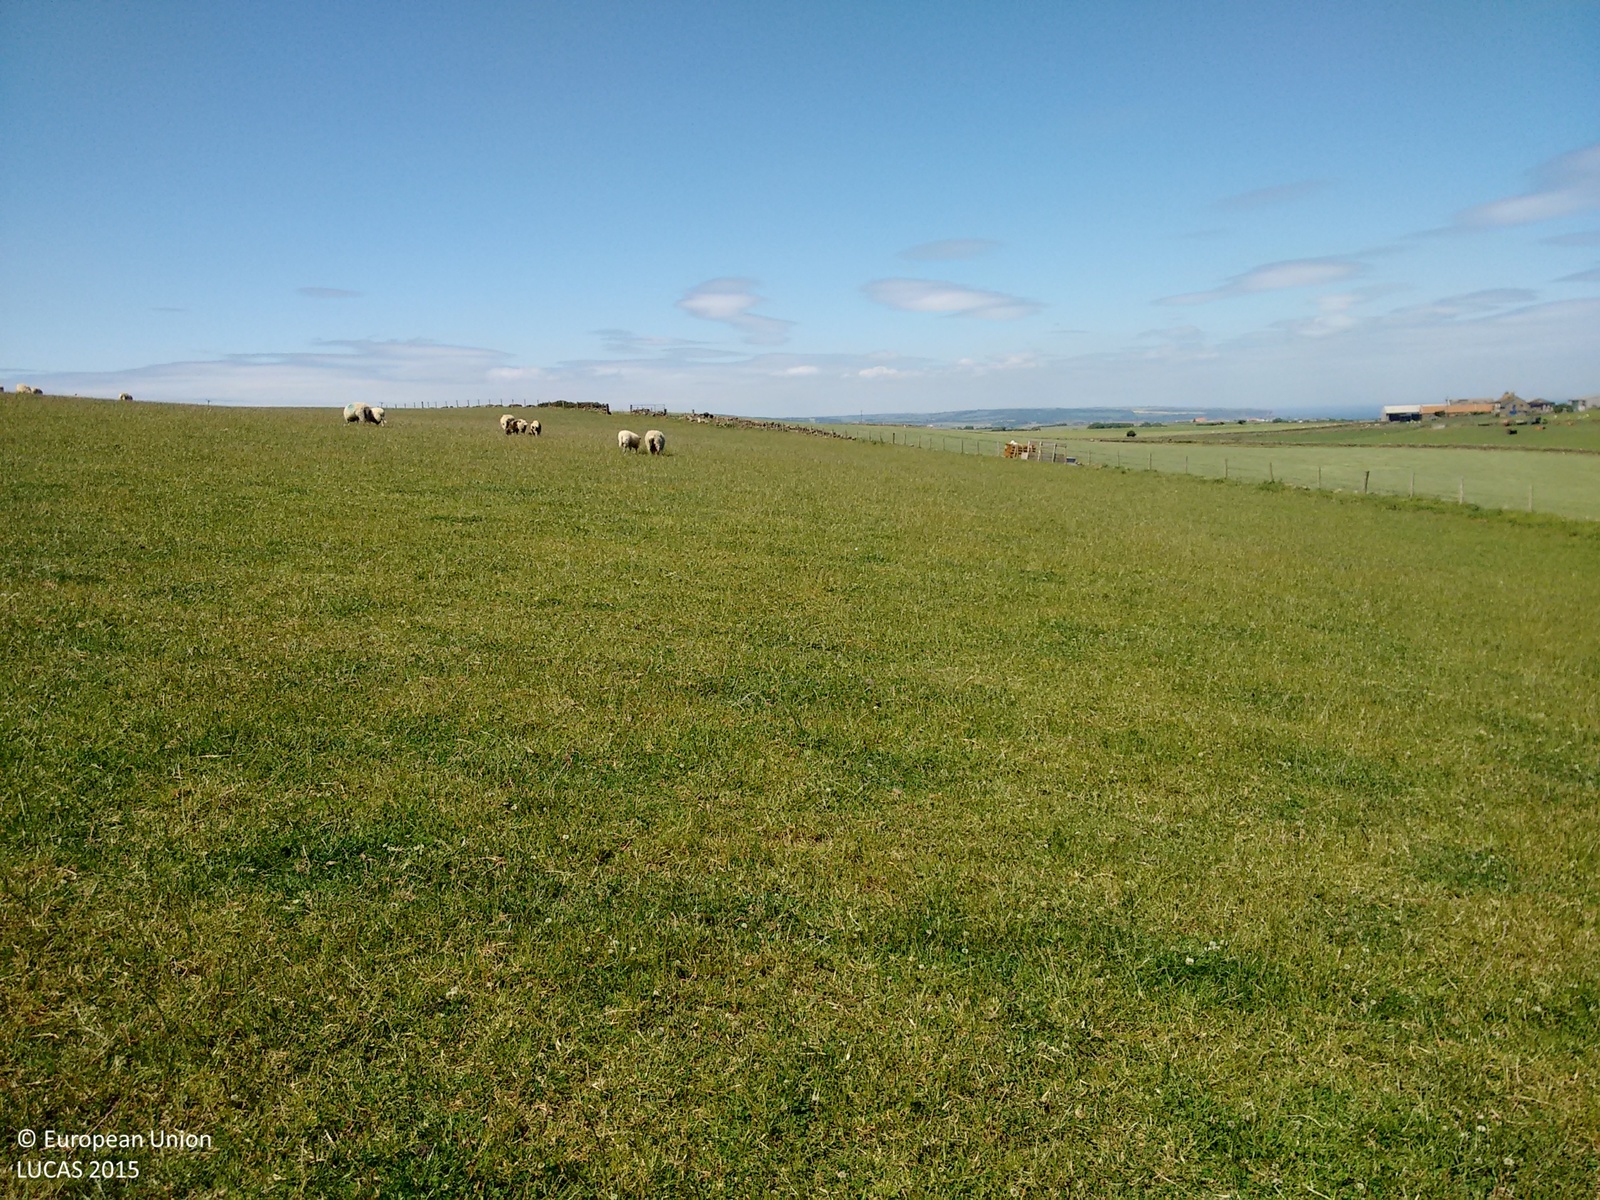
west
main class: Grassland
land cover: Grassland without tree/shrub cover
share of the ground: > 75 %
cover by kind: herbaceous plants 100 %
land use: Agriculture (excluding fallow land and kitchen gardens)
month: June
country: GB
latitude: 54.4463
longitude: -0.5380
